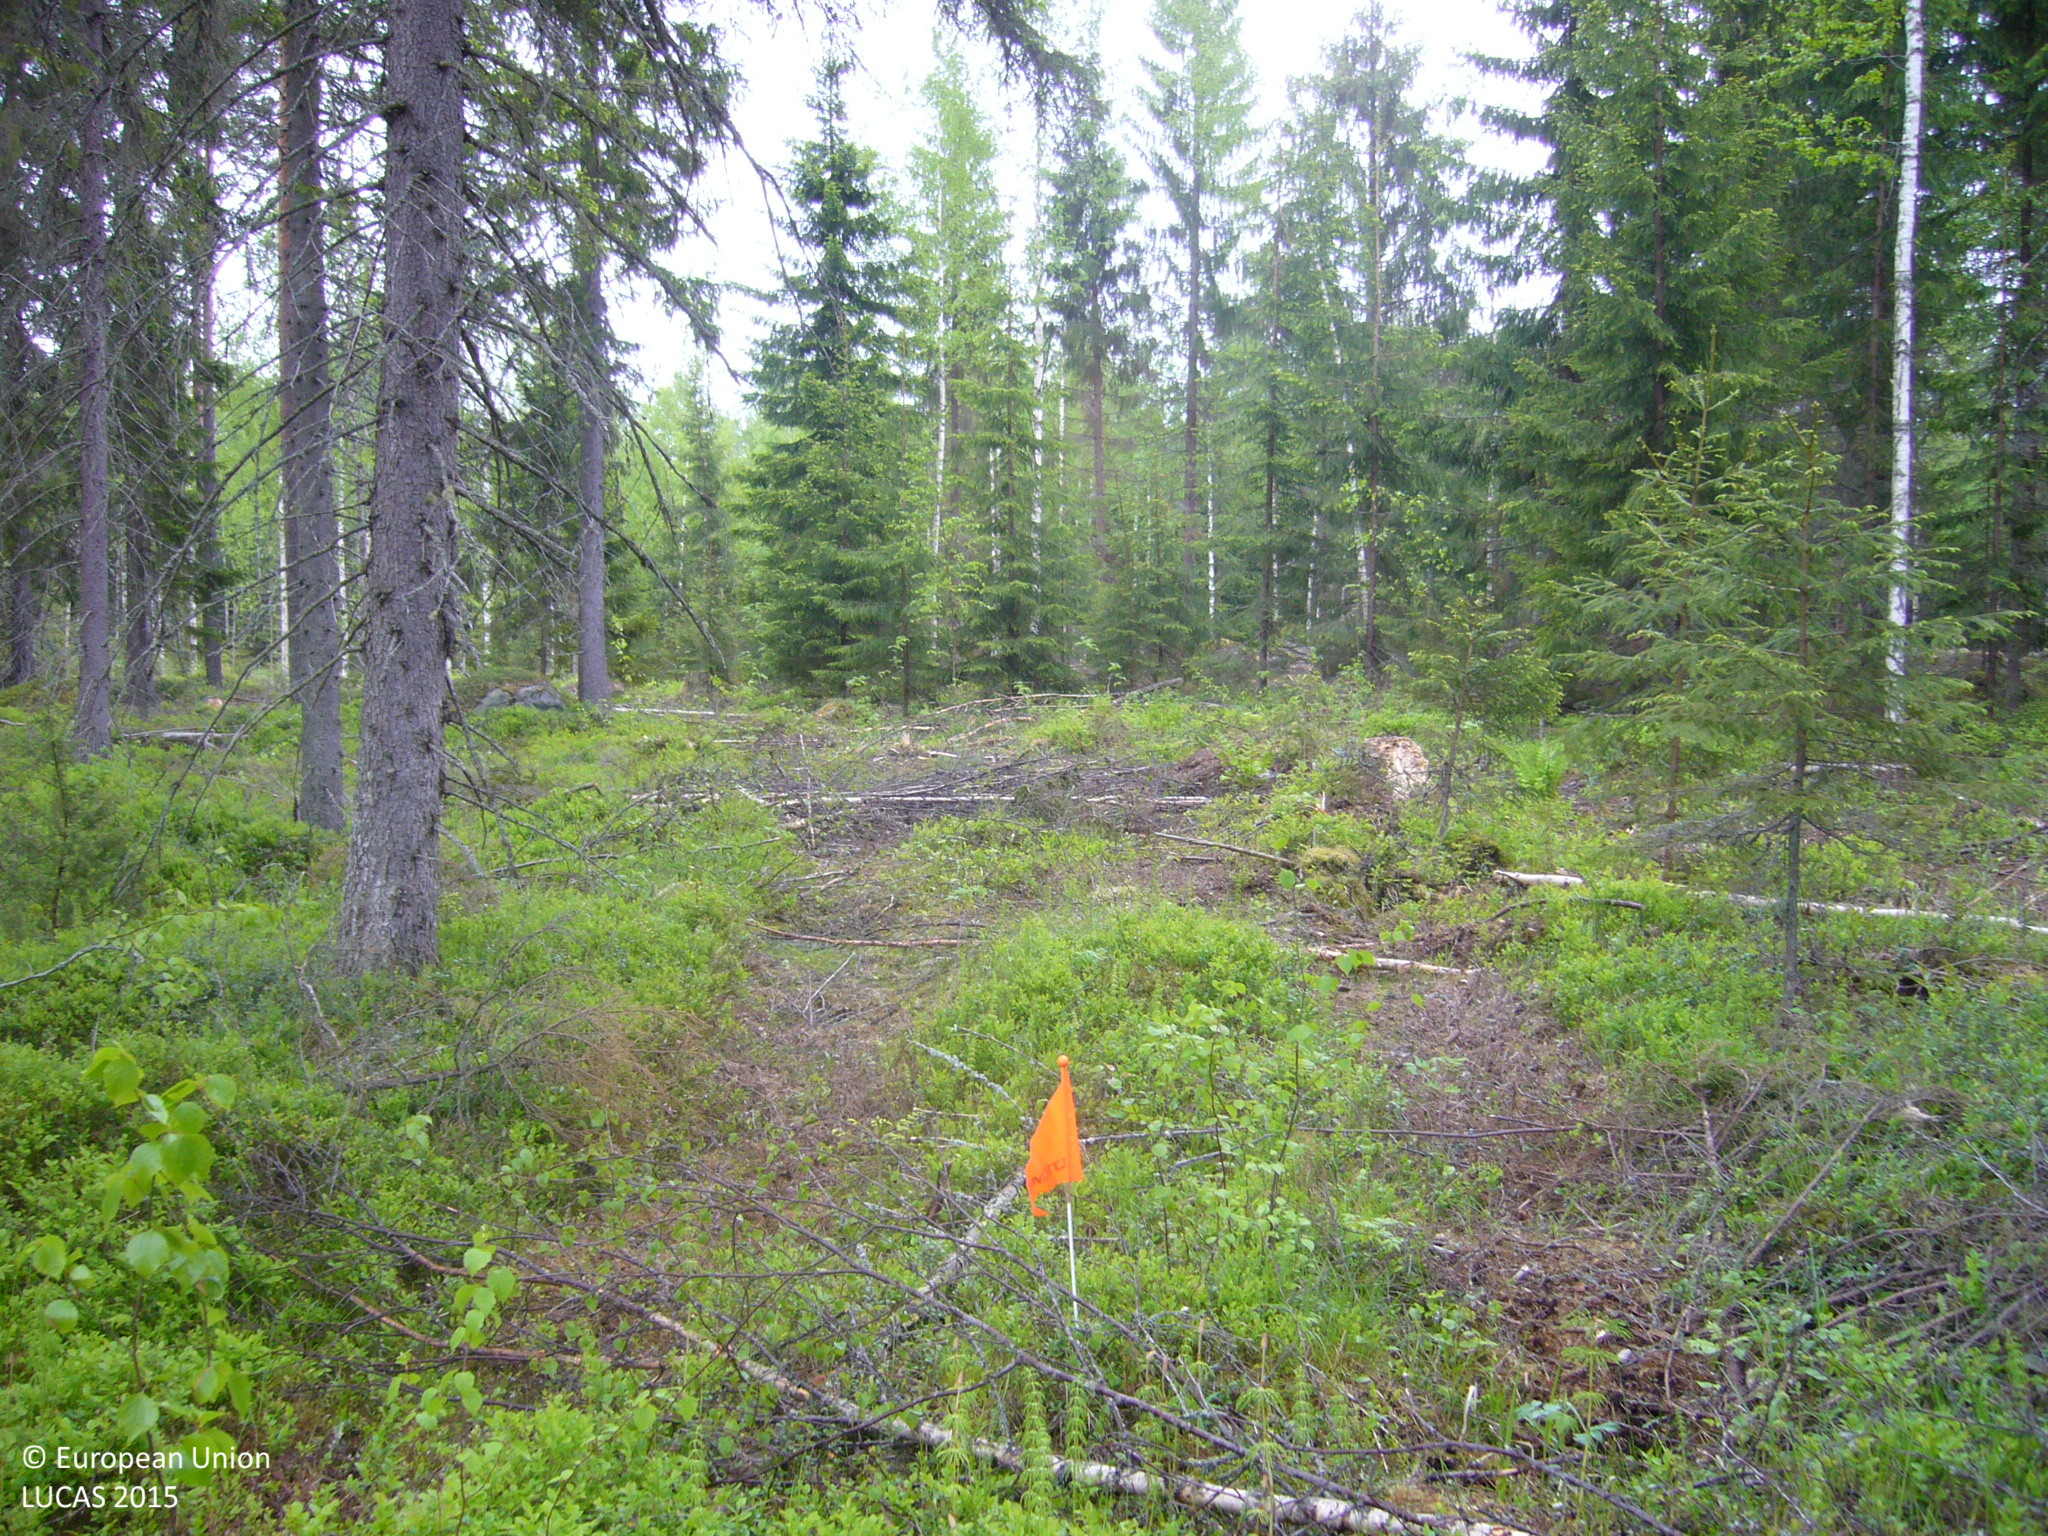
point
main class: Woodland
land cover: Spruce dominated coniferous woodland
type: boreal forest
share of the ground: 50 - 75 %
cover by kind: coniferous forest trees 60 %, shrubs 40 %
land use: Forestry
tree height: > 5 m
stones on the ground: 25 - 50 %
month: June
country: FI
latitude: 63.2326
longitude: 26.6321
